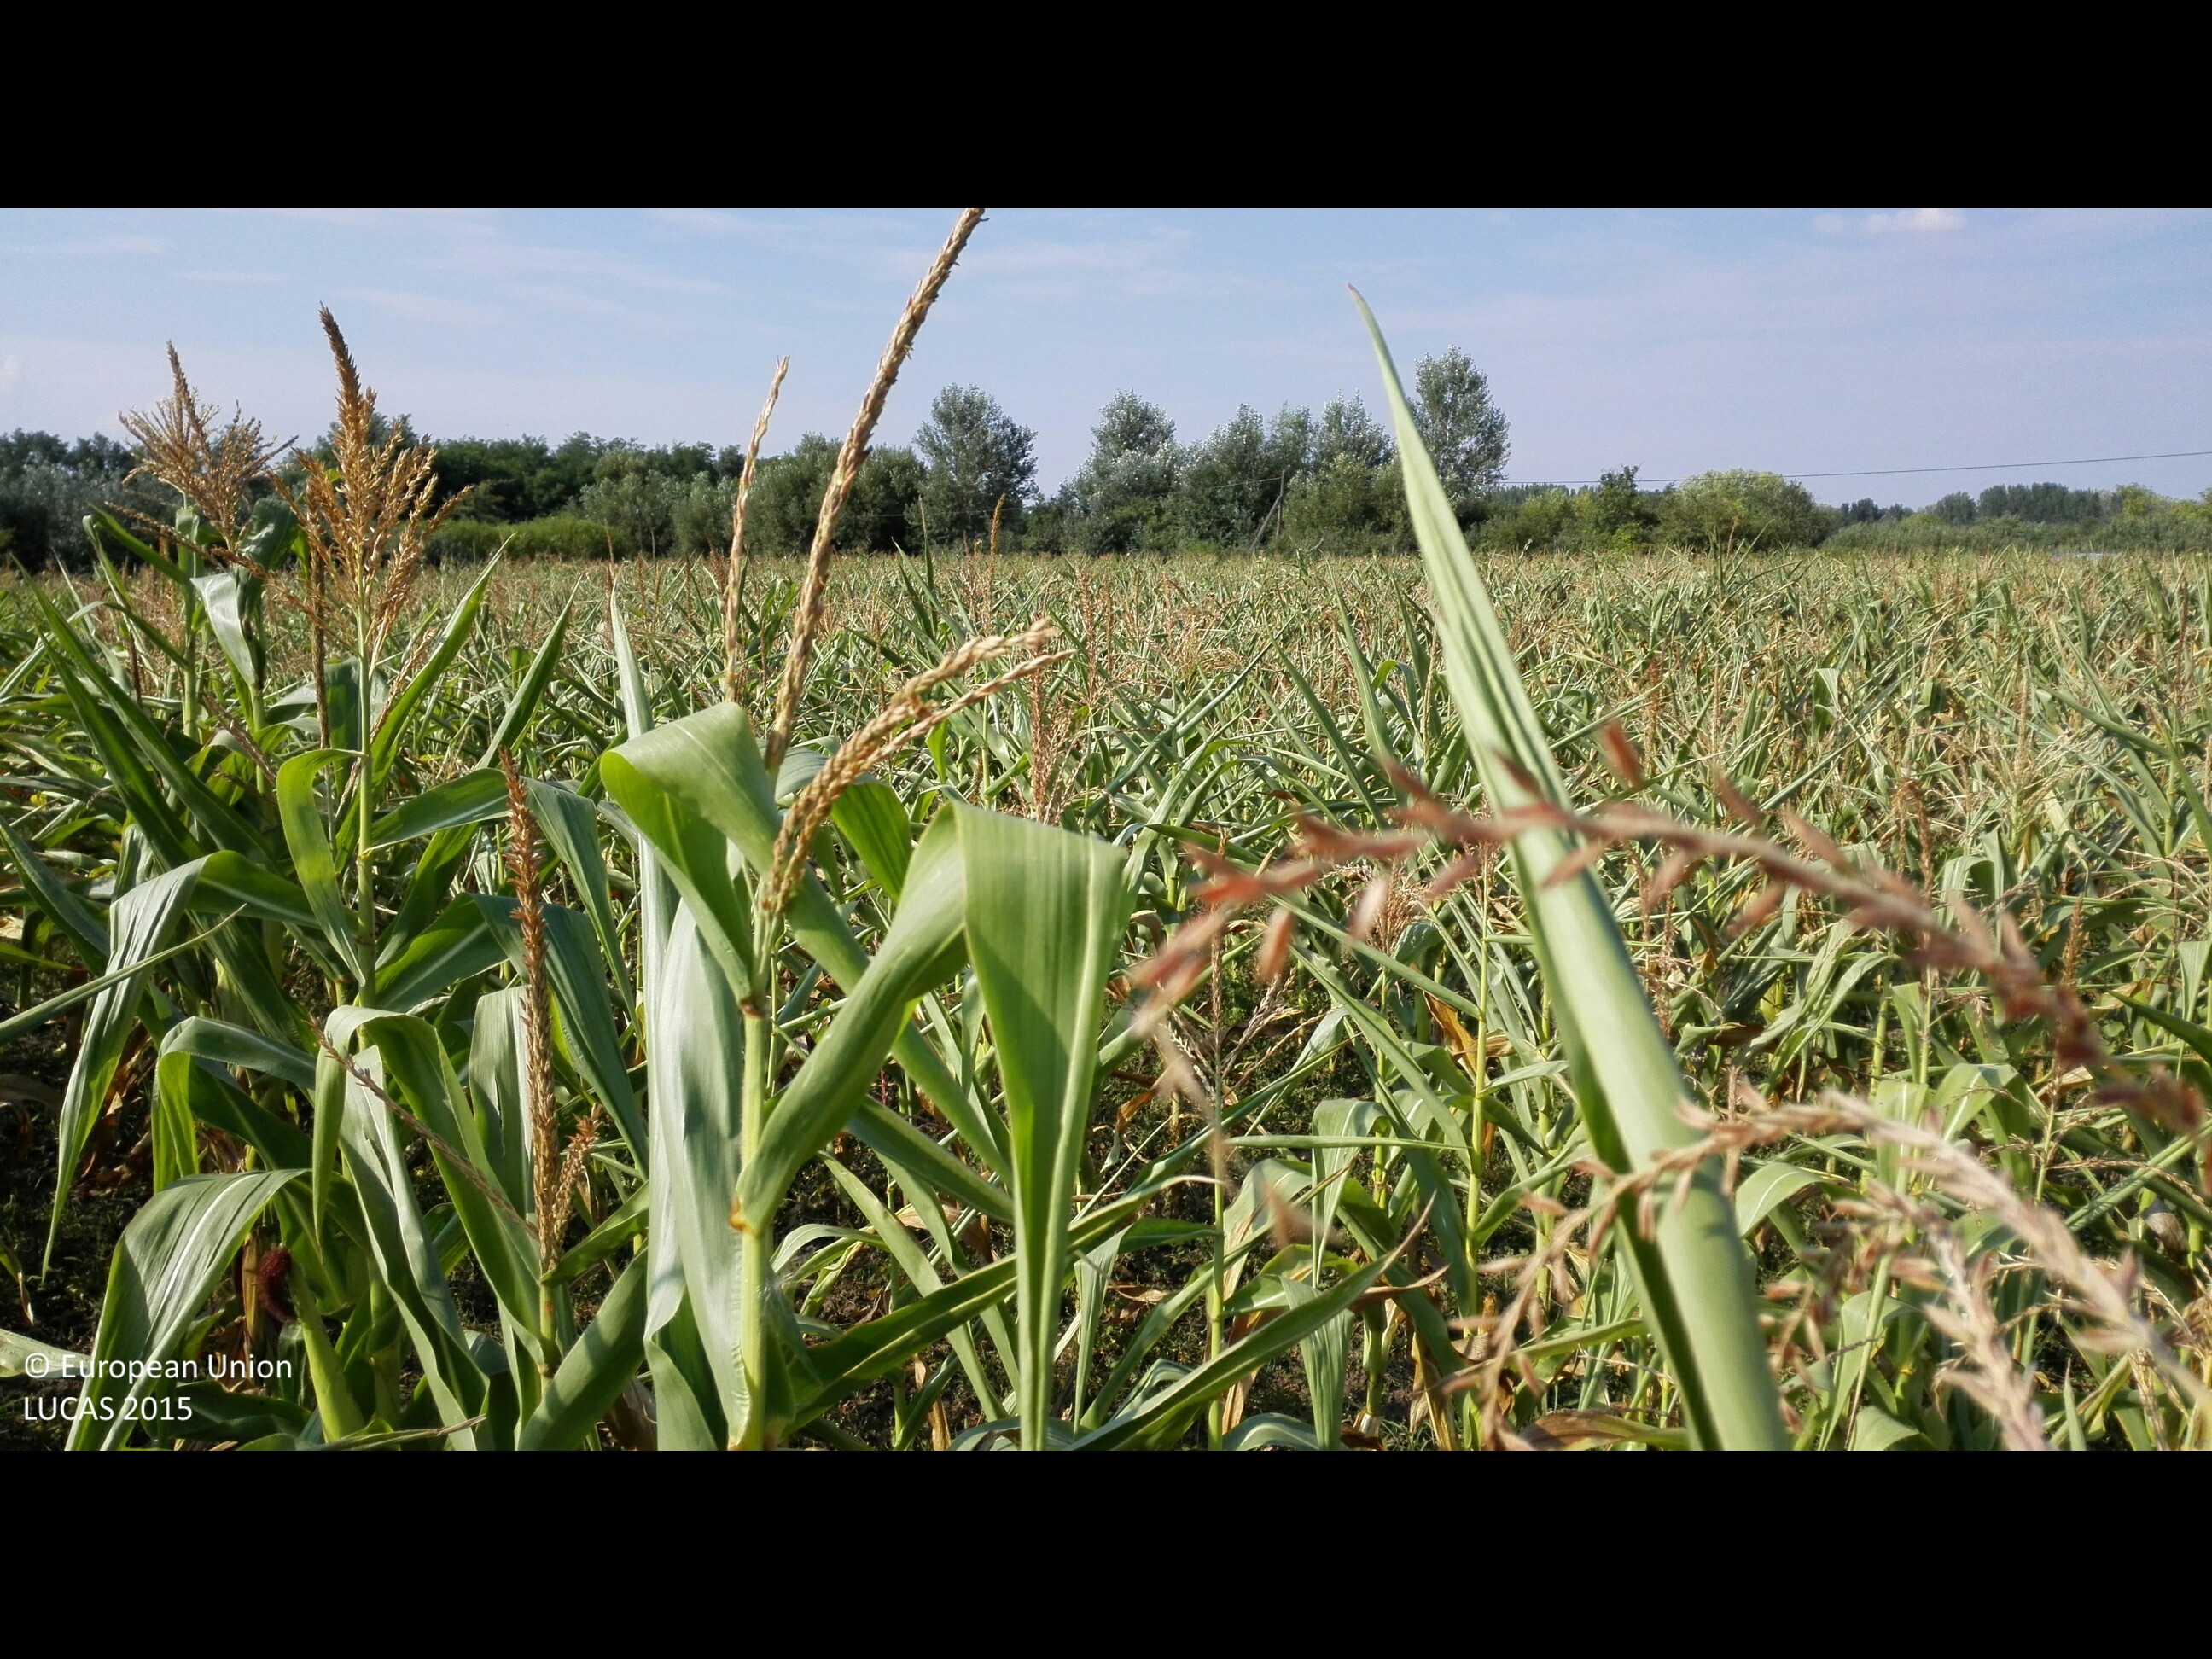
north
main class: Cropland
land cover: Maize
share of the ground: > 75 %
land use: Agriculture (excluding fallow land and kitchen gardens)
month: August
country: HU
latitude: 47.6211
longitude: 21.8233
